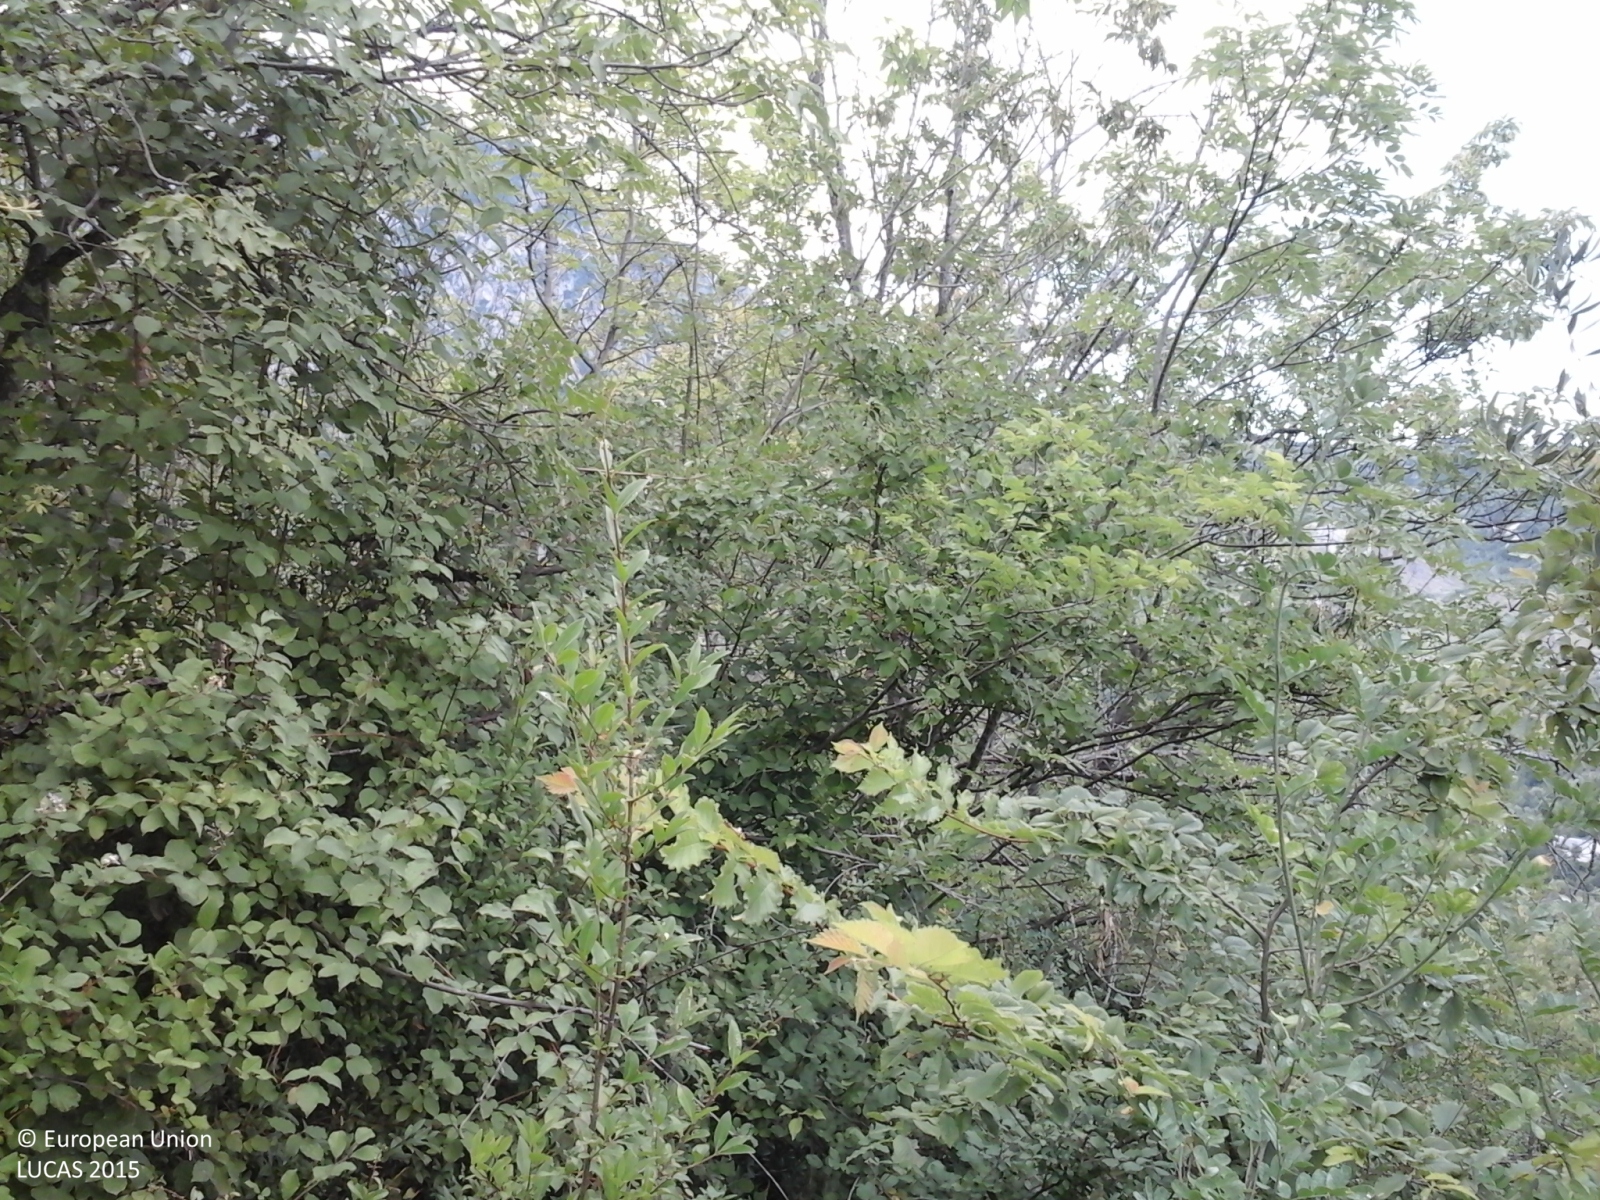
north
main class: Shrubland
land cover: Shrubland with sparse tree cover
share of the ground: > 75 %
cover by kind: shrubs 90 %, broadleaved forest trees 5 %, herbaceous plants 5 %
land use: Semi-natural and natural areas not in use
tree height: < 5 m
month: June
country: IT
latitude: 42.0954
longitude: 14.2303
